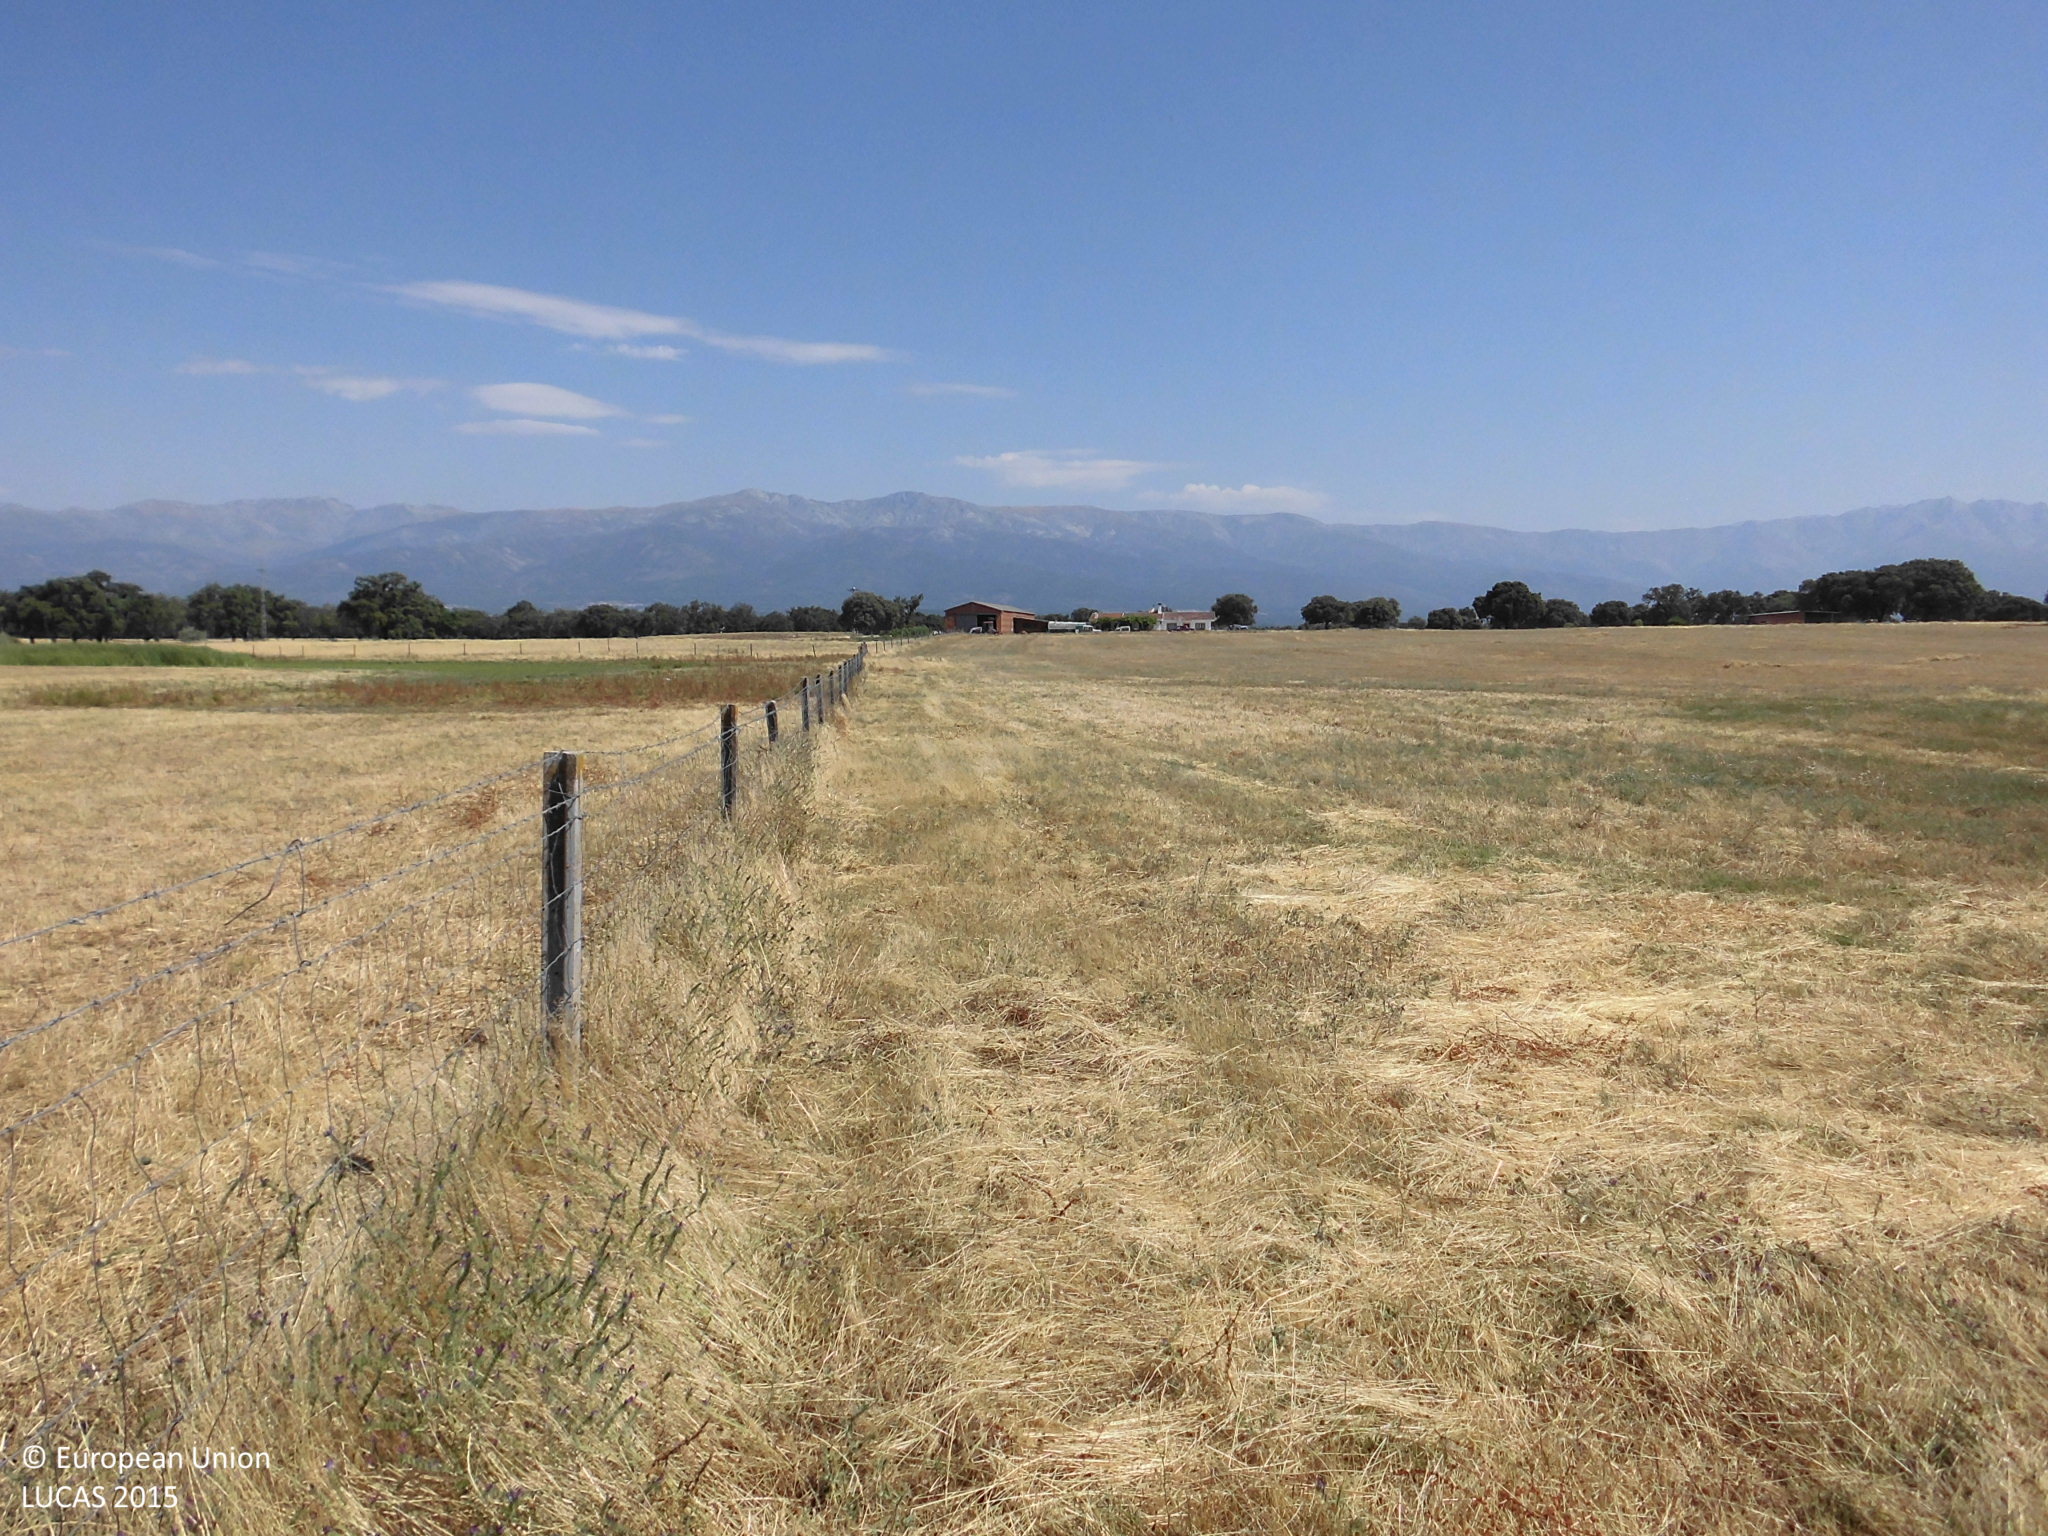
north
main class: Woodland
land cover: Broadleaved woodland
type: broadleaved evergreen forest
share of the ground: 10 - 25 %
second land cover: Grassland without tree/shrub cover
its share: > 75 %
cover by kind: herbaceous plants 85 %, broadleaved forest trees 10 %, unconsolidated bare surface 5 %
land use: Forestry
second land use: Agriculture (excluding fallow land and kitchen gardens)
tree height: > 5 m
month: June
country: ES
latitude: 40.0035
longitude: -5.4868
